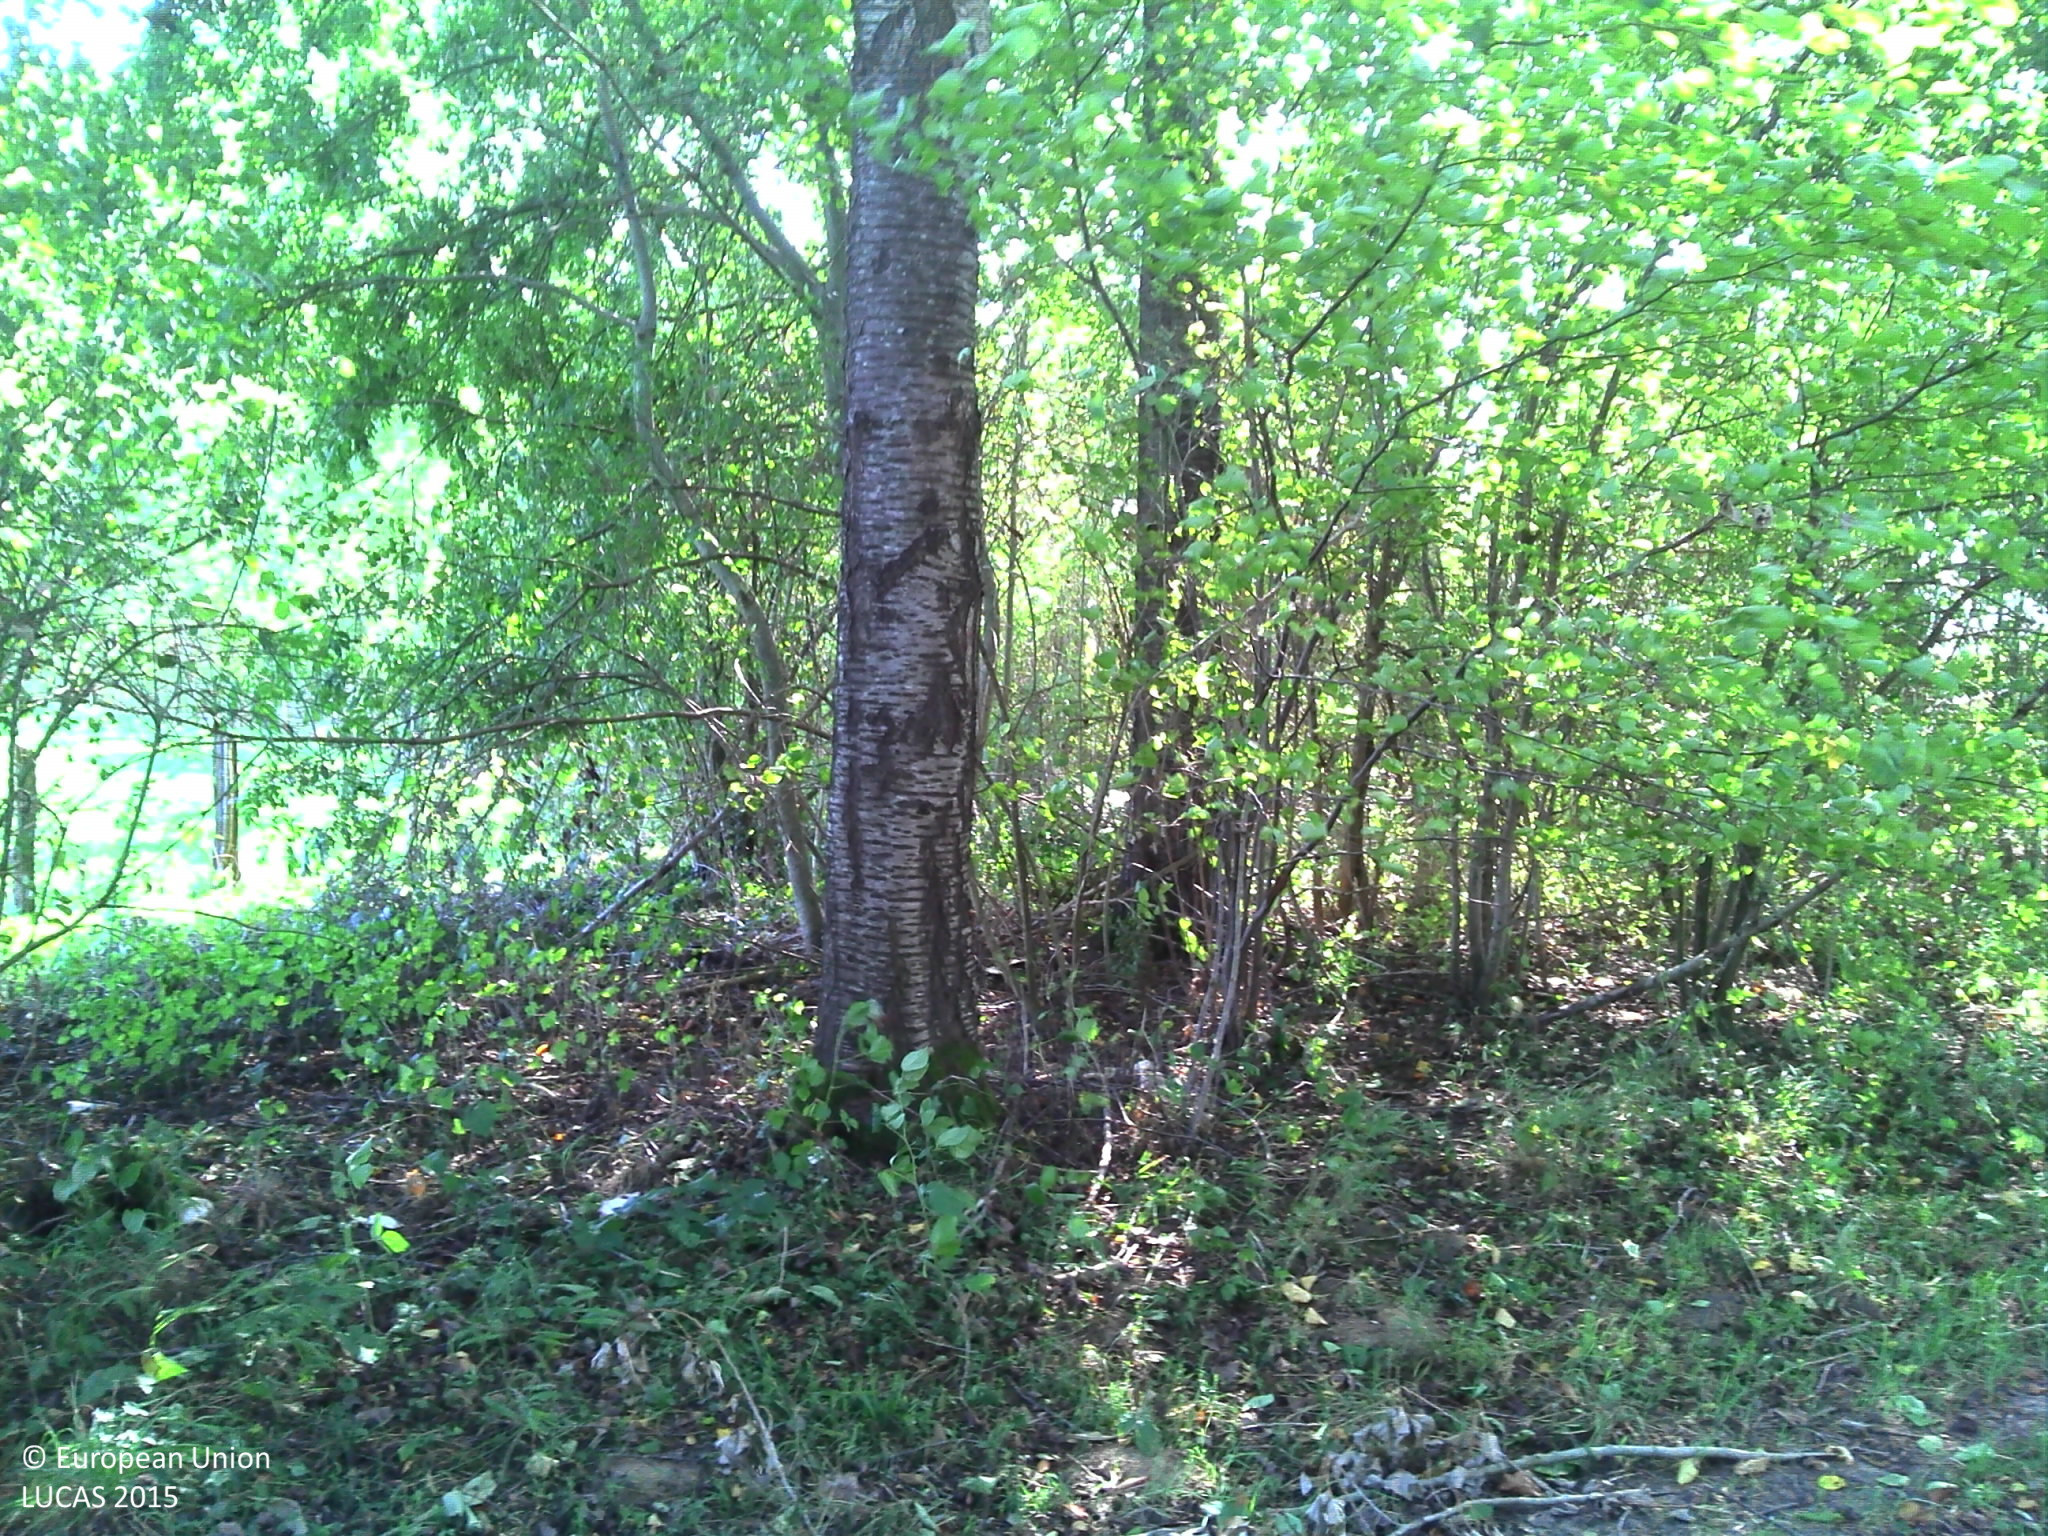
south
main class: Woodland
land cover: Broadleaved woodland
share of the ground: > 75 %
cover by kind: broadleaved forest trees 100 %
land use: Semi-natural and natural areas not in use
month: September
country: FR
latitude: 48.4162
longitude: 4.6066
